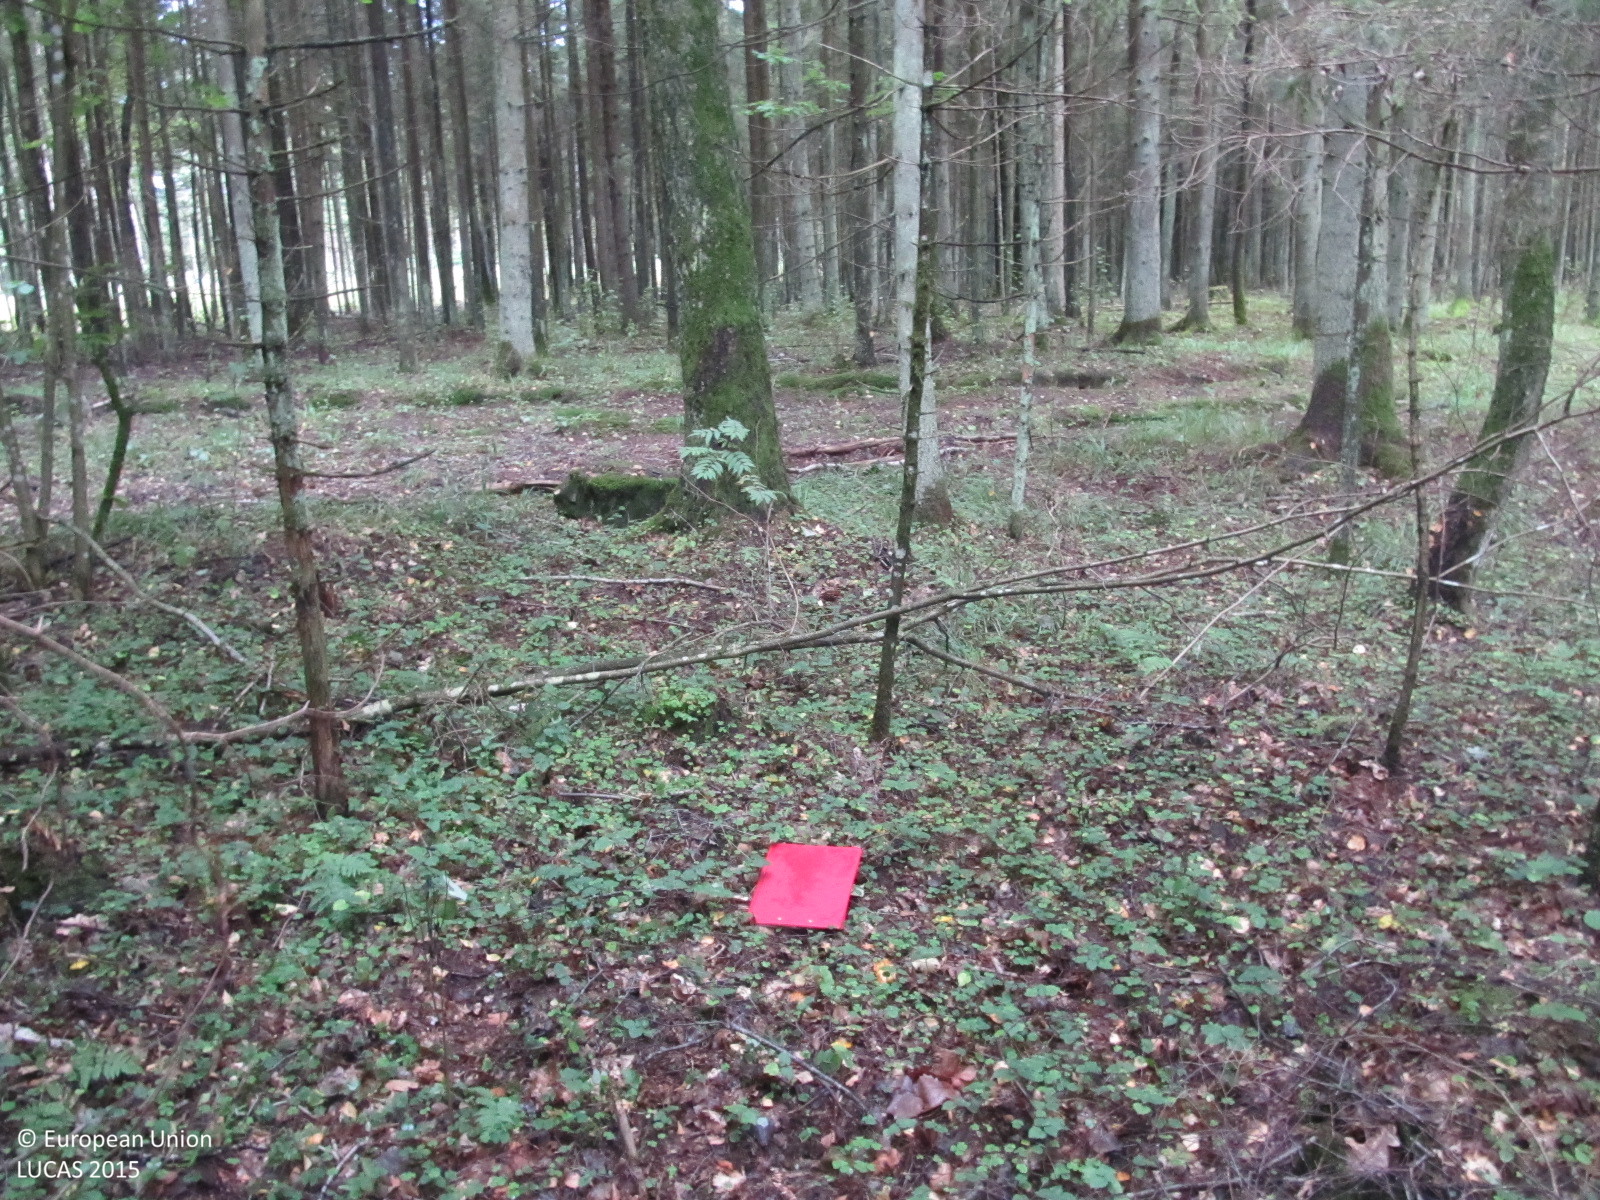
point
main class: Woodland
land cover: Spruce dominated mixed woodland
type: non-riverine alder, birch or aspen forest
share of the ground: > 75 %
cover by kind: coniferous forest trees 50 %, broadleaved forest trees 30 %, herbaceous plants 10 %, lichens and mosses 5 %, unconsolidated bare surface 5 %
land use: Forestry
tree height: > 5 m
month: September
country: LT
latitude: 55.9979
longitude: 22.8115
